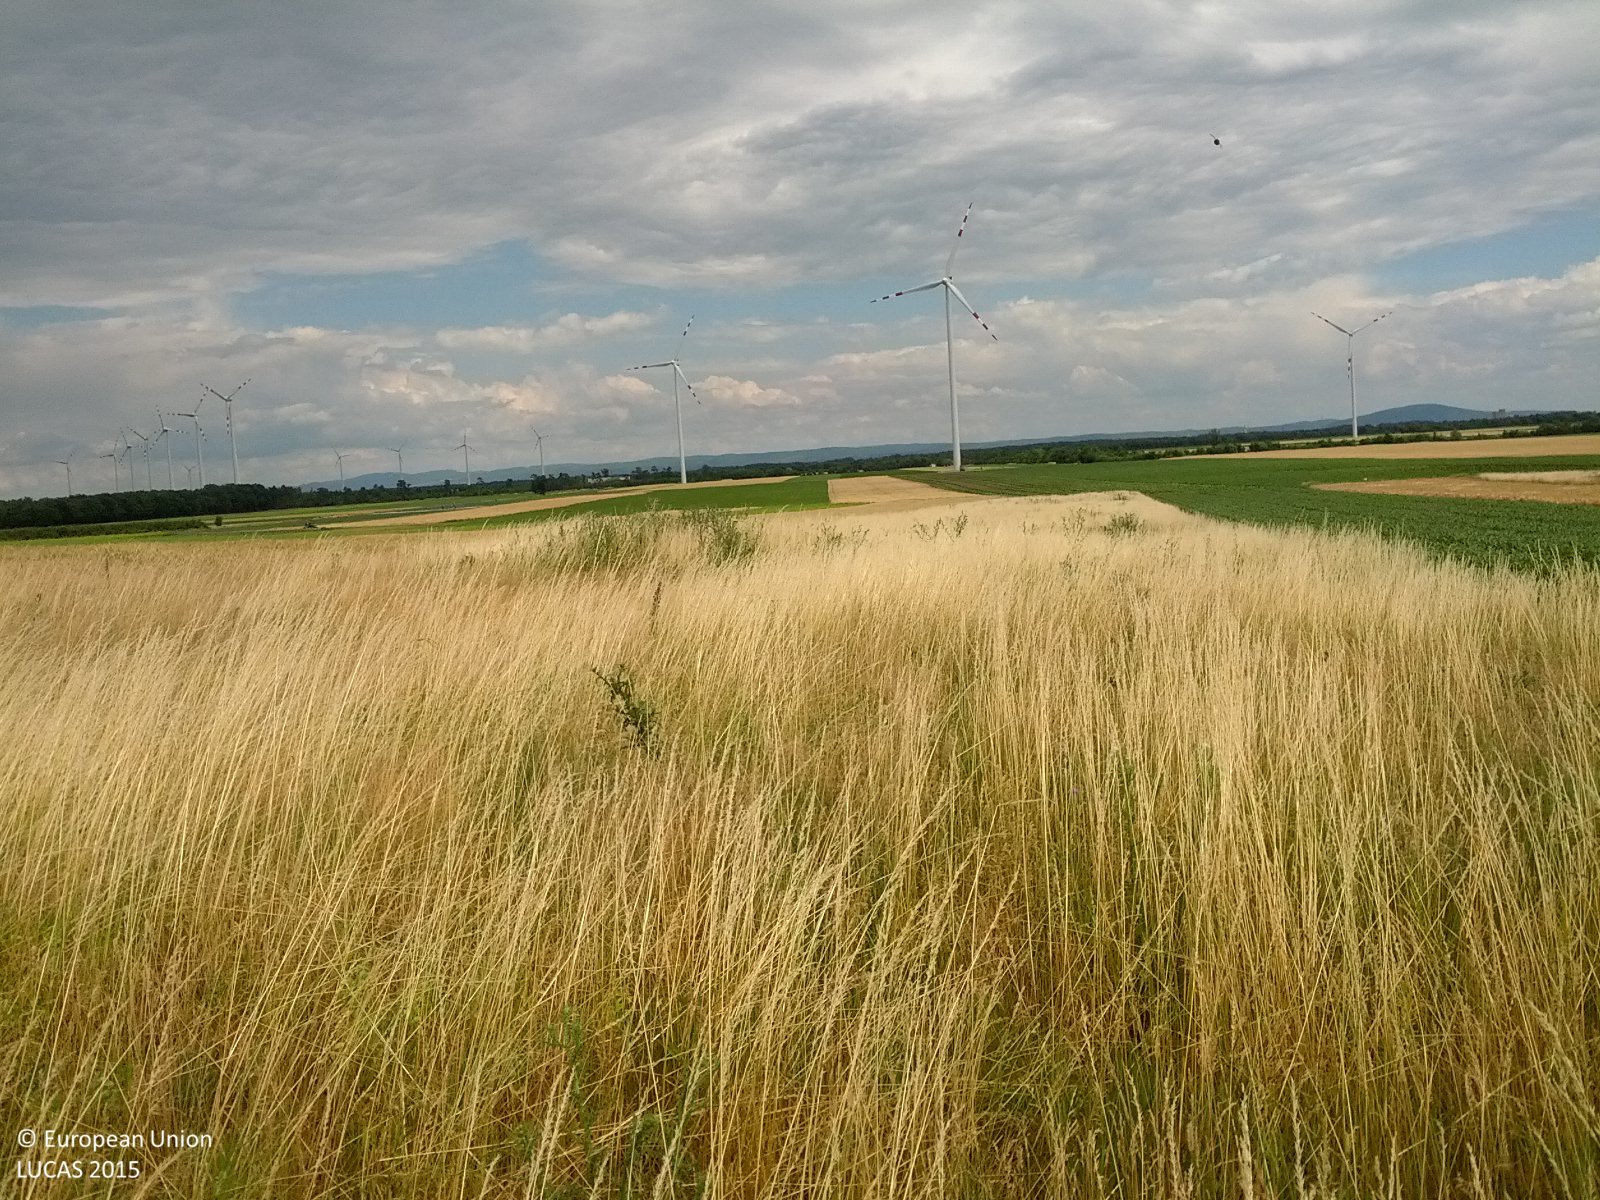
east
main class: Grassland
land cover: Grassland without tree/shrub cover
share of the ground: > 75 %
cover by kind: herbaceous plants 100 %
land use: Agriculture (excluding fallow land and kitchen gardens)
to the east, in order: Grassland without tree/shrub cover; Durum wheat; Other fibre and oleaginous crops
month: June
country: AT
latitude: 48.2755
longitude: 16.6490
